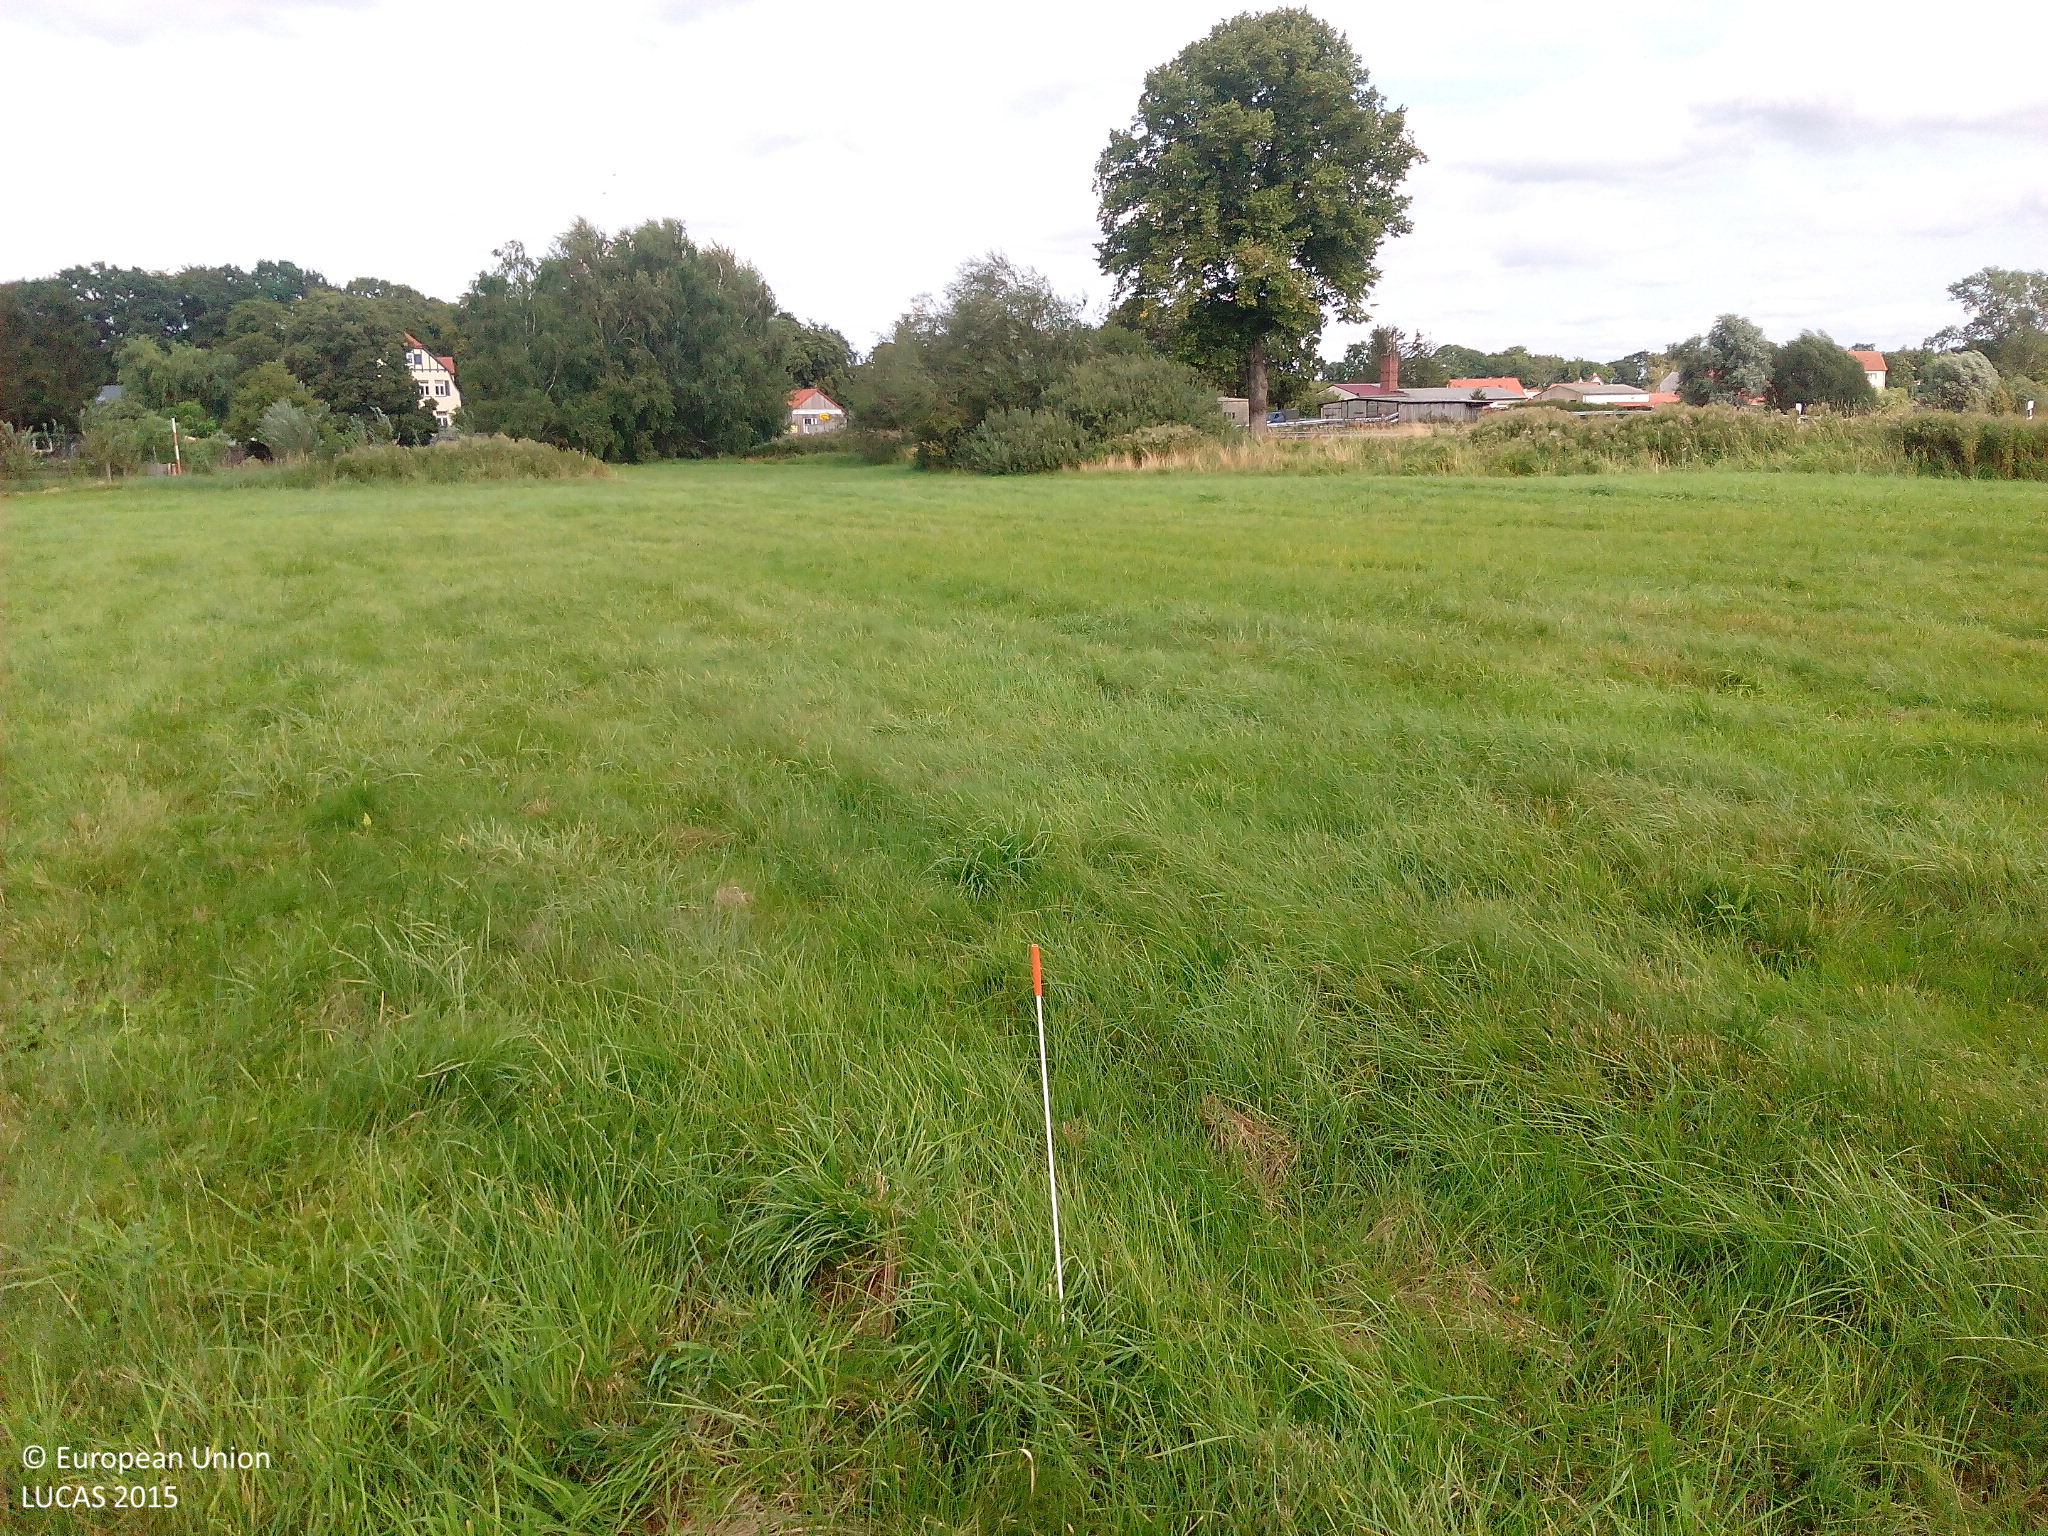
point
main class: Grassland
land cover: Grassland without tree/shrub cover
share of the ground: > 75 %
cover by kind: herbaceous plants 100 %
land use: Agriculture (excluding fallow land and kitchen gardens)
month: August
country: DE
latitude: 53.9654
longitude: 12.6972
